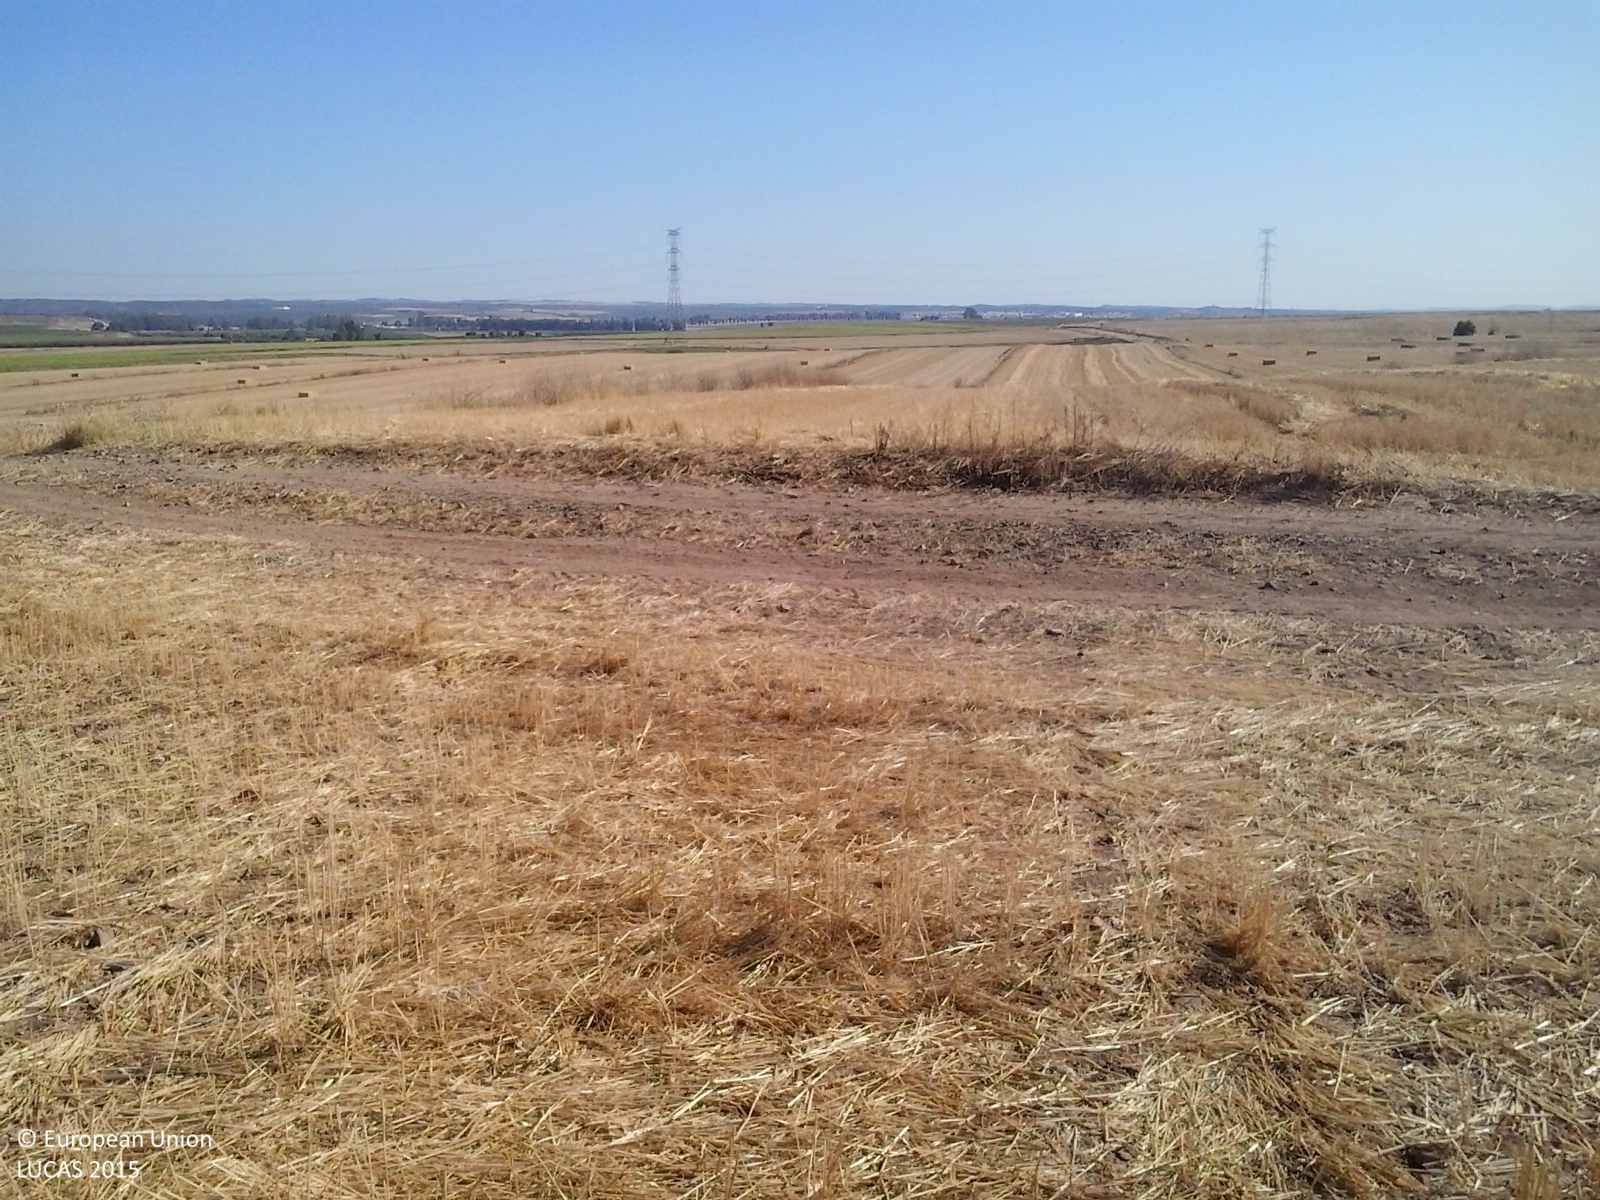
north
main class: Cropland
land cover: Common wheat
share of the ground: < 10 %
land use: Agriculture (excluding fallow land and kitchen gardens)
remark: Harvested field
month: June
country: ES
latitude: 37.4758
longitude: -6.1876
